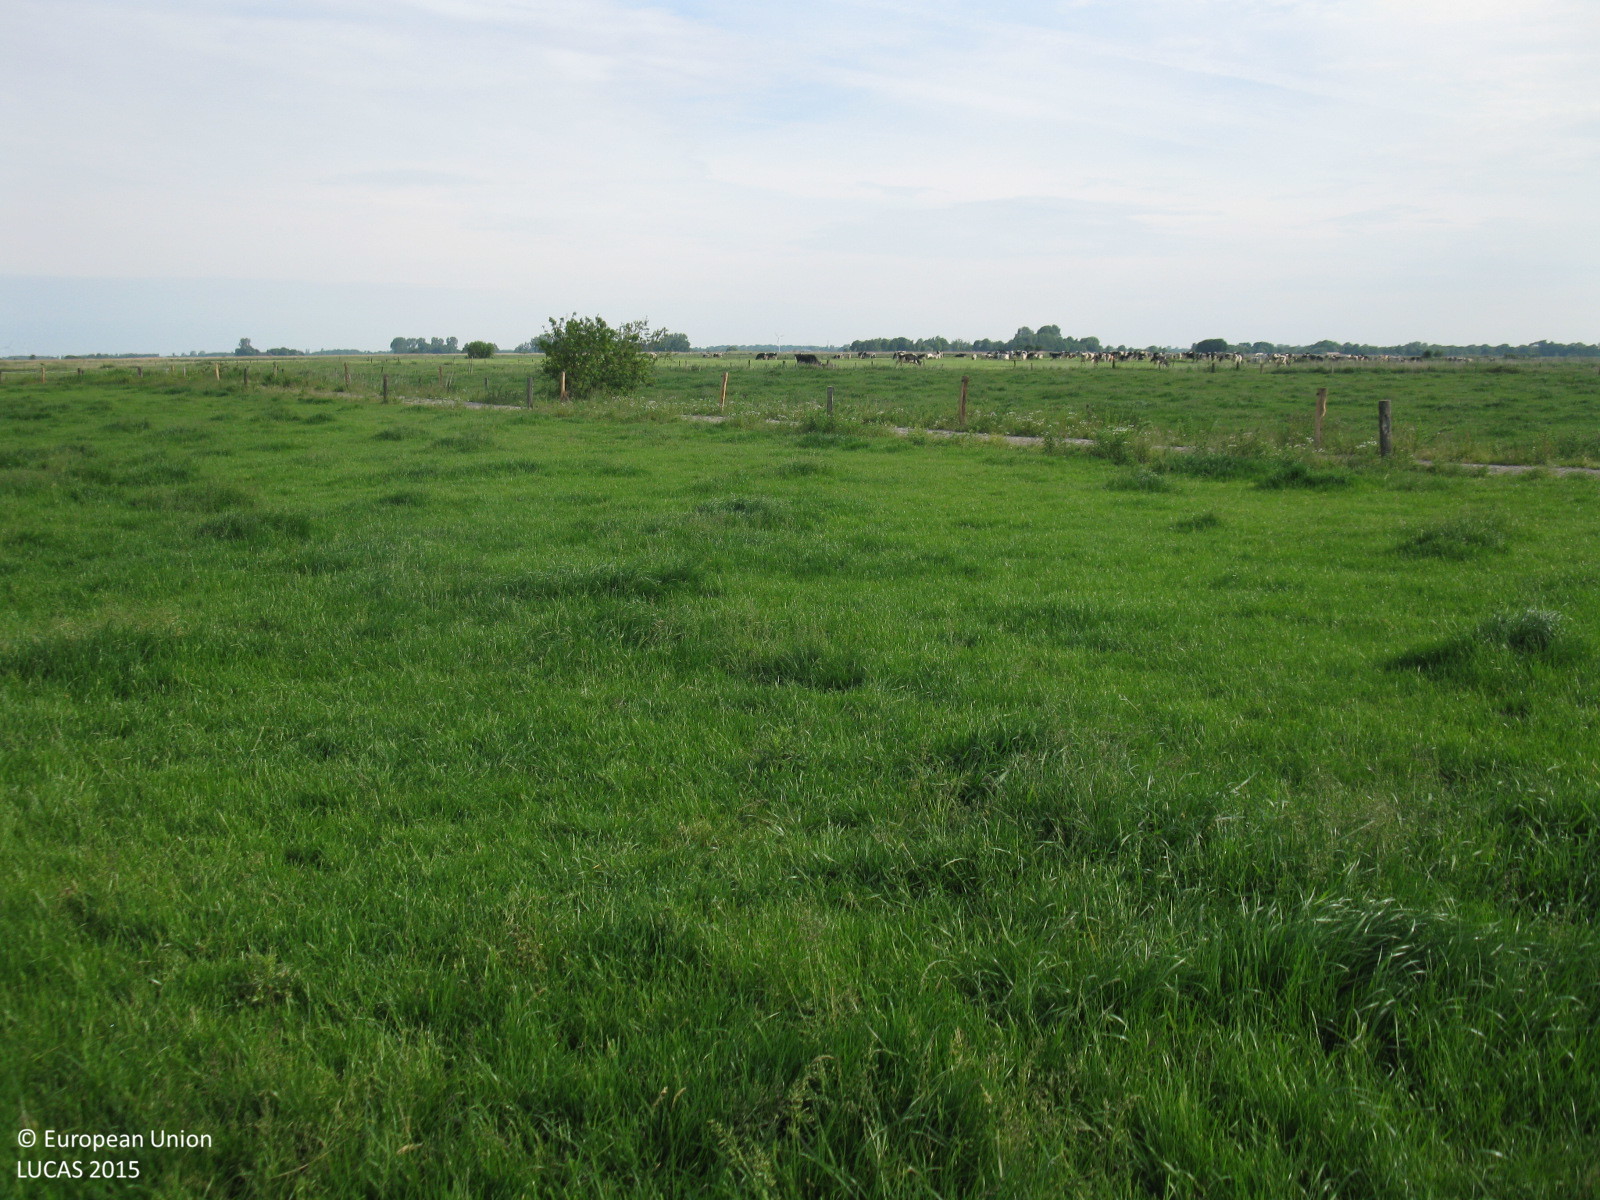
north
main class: Grassland
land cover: Grassland without tree/shrub cover
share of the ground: > 75 %
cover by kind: herbaceous plants 100 %
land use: Agriculture (excluding fallow land and kitchen gardens)
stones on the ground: < 10 %
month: June
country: DE
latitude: 53.4612
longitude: 7.2745
